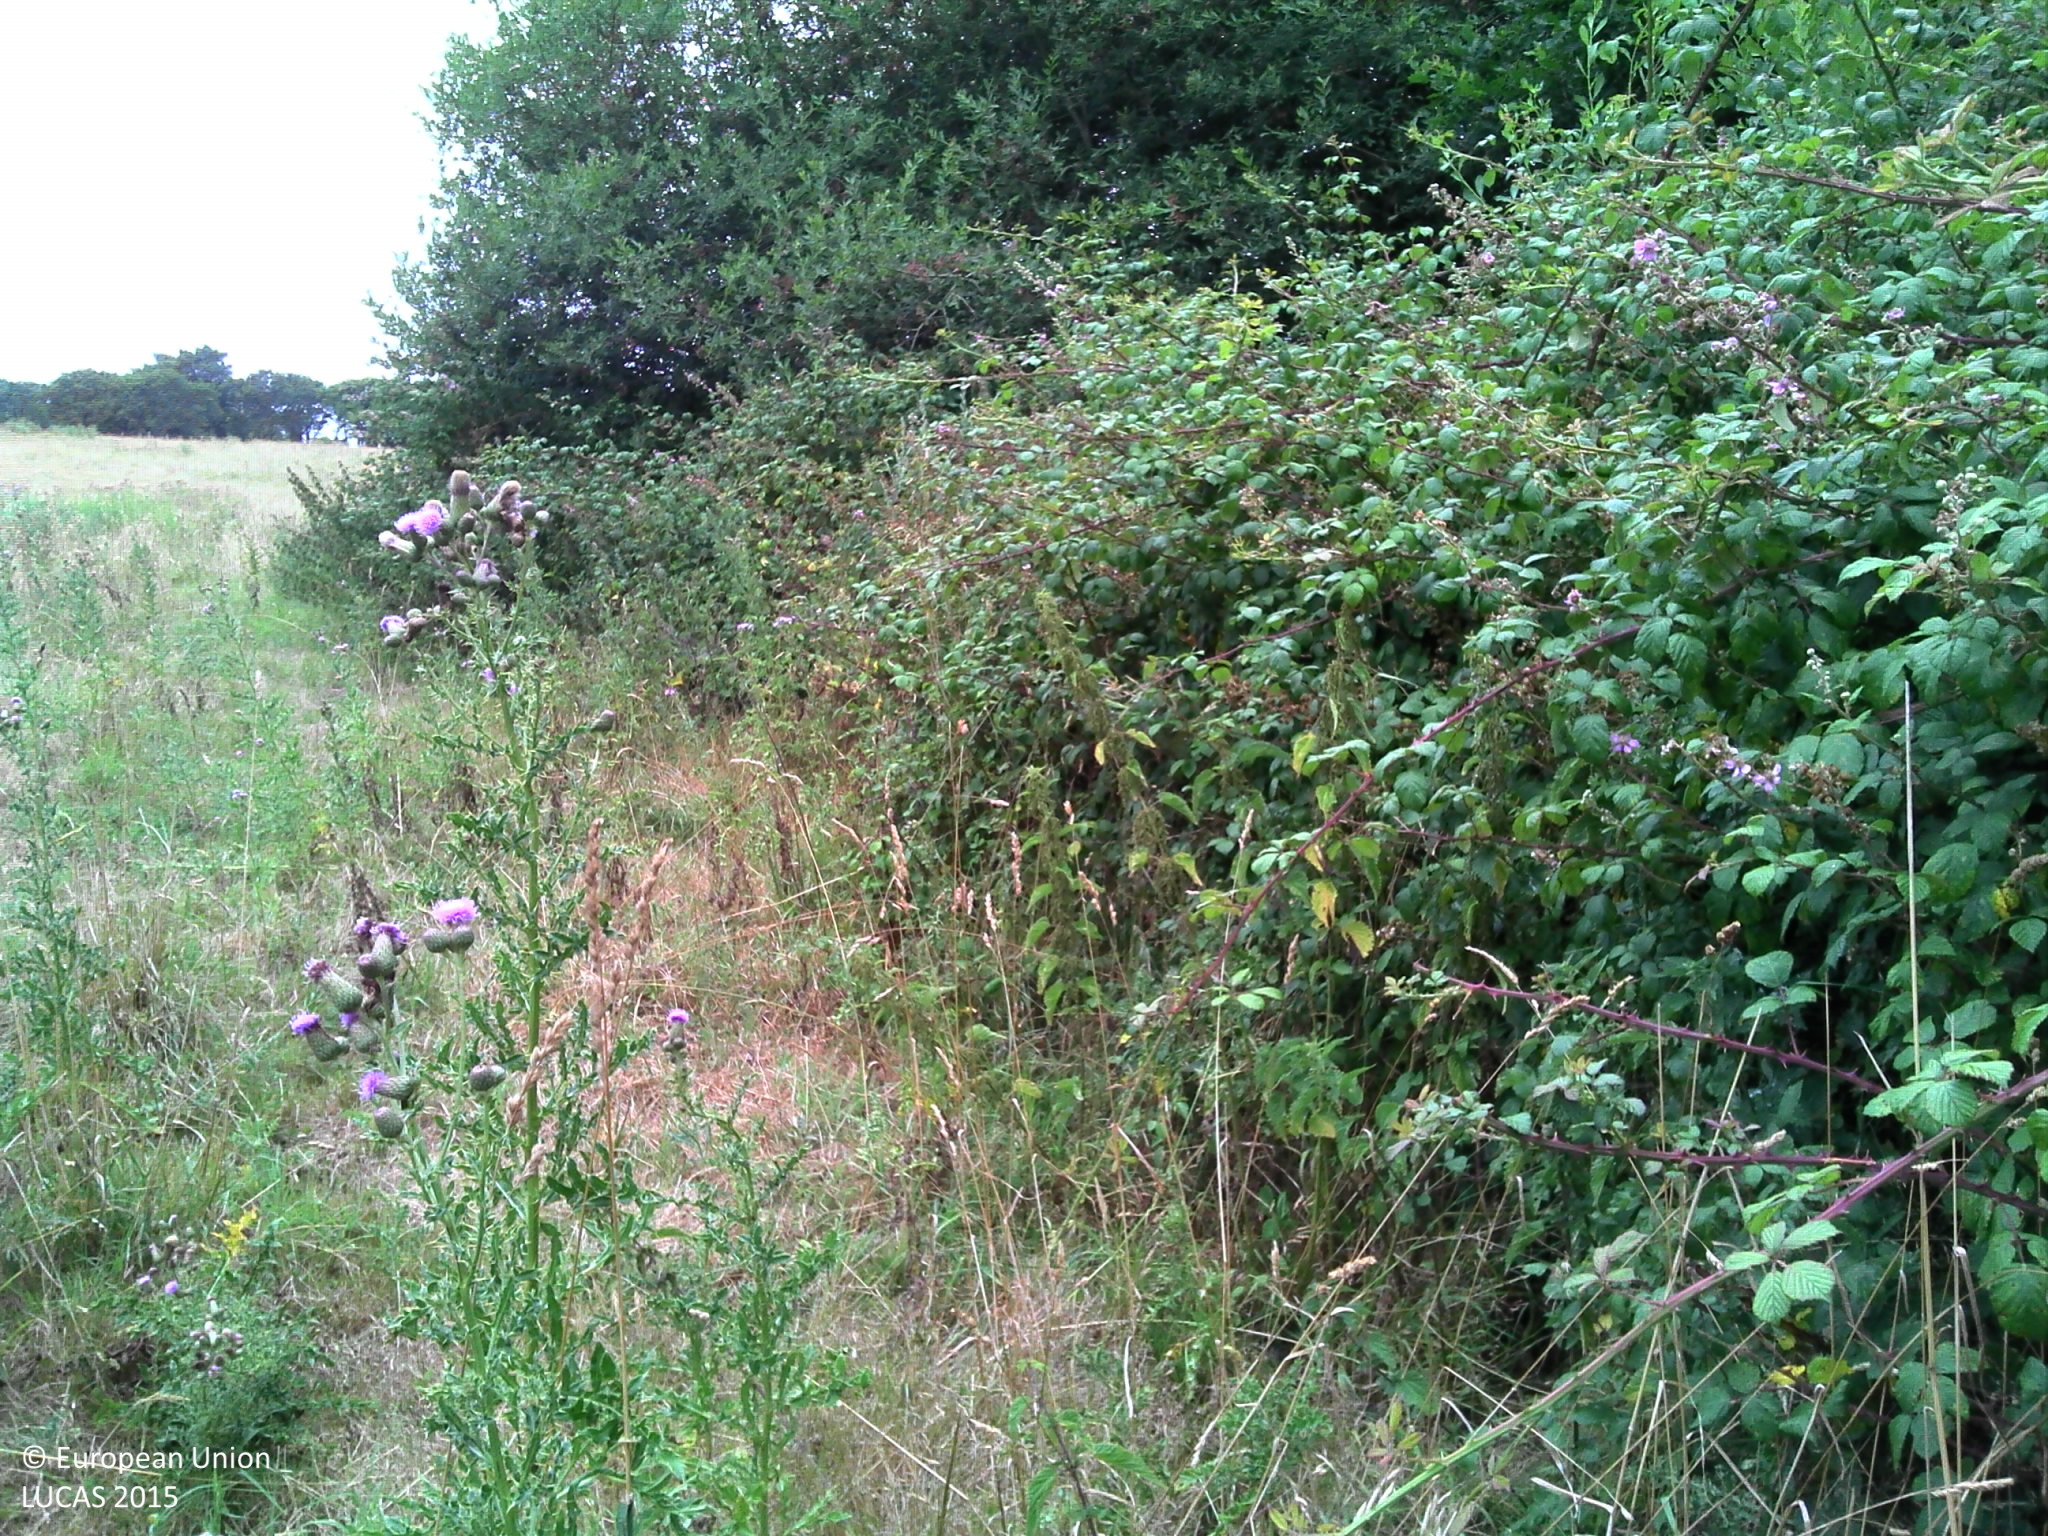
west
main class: Woodland
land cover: Broadleaved woodland
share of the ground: > 75 %
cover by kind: broadleaved forest trees 50 %, shrubs 30 %, herbaceous plants 10 %, consolidated bare surface 10 %
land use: Forestry
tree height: < 5 m
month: July
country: FR
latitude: 47.7141
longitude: -3.2262
